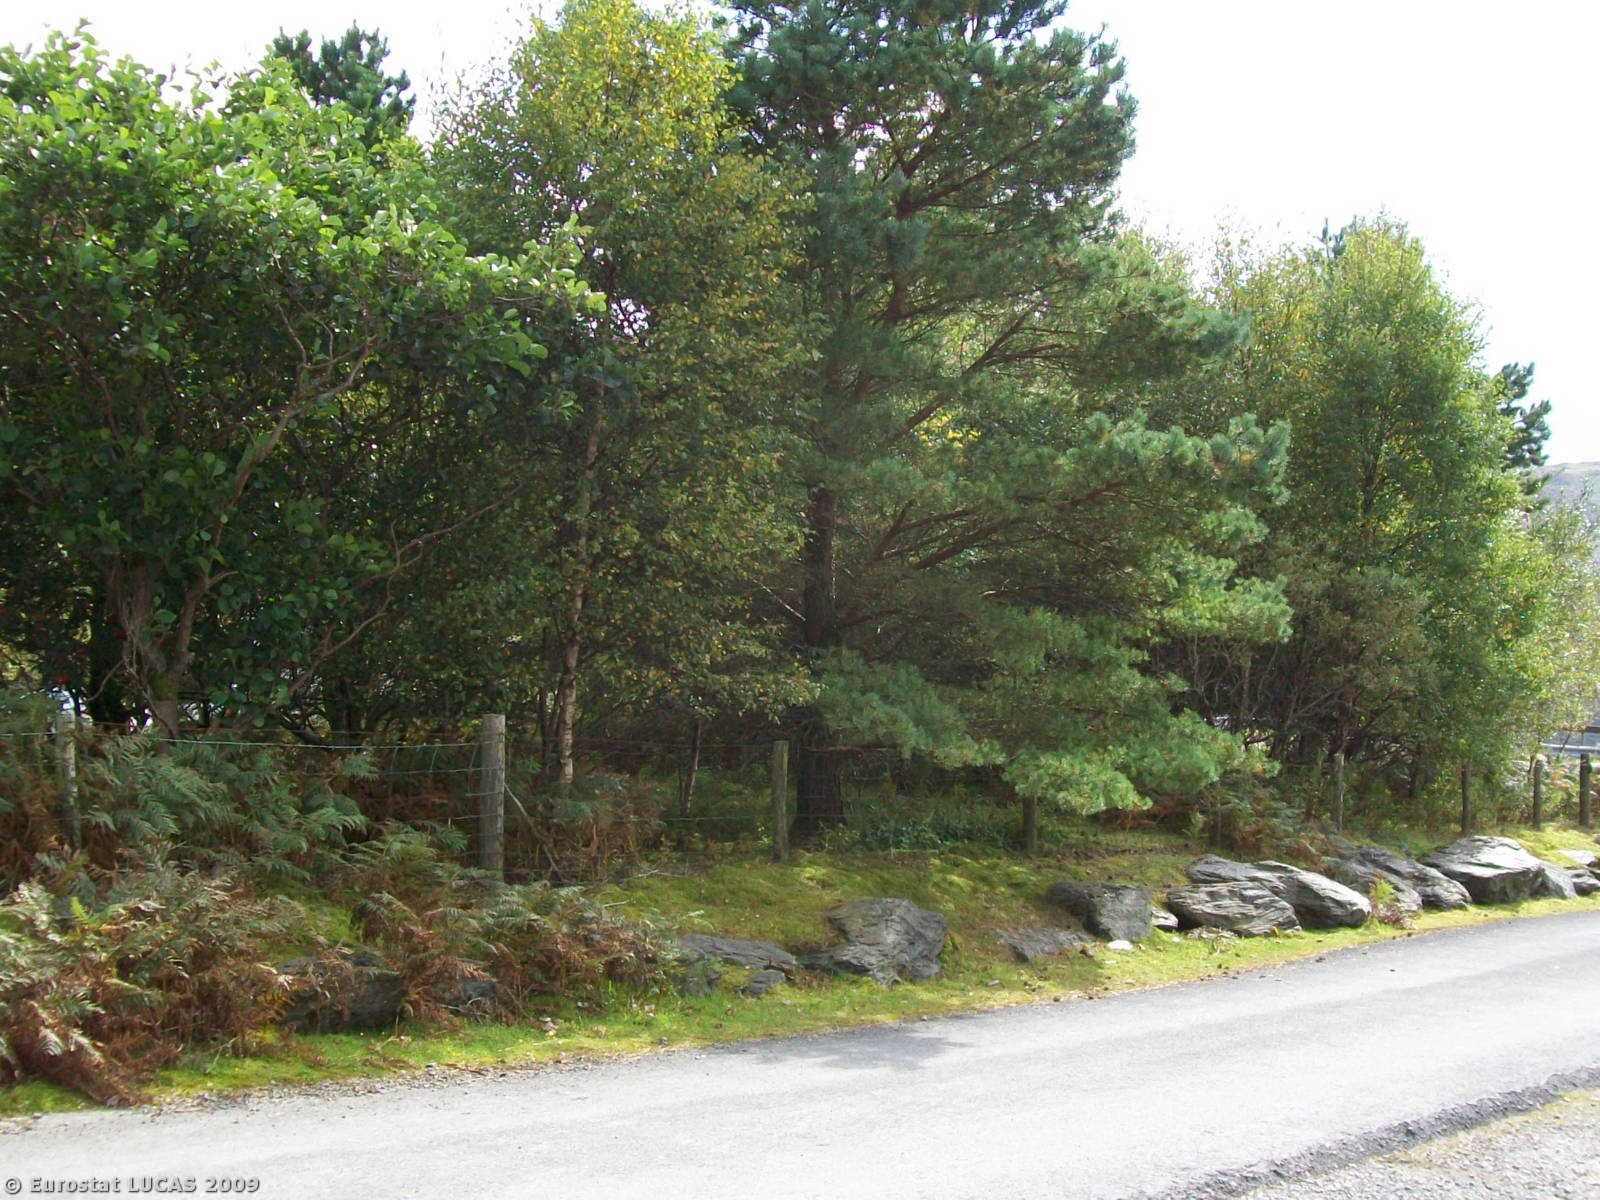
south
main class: Shrubland
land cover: Shrubland without tree cover
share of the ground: > 75 %
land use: Agriculture (excluding fallow land and kitchen gardens)
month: September
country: GB
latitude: 52.1521
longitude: -3.7849
